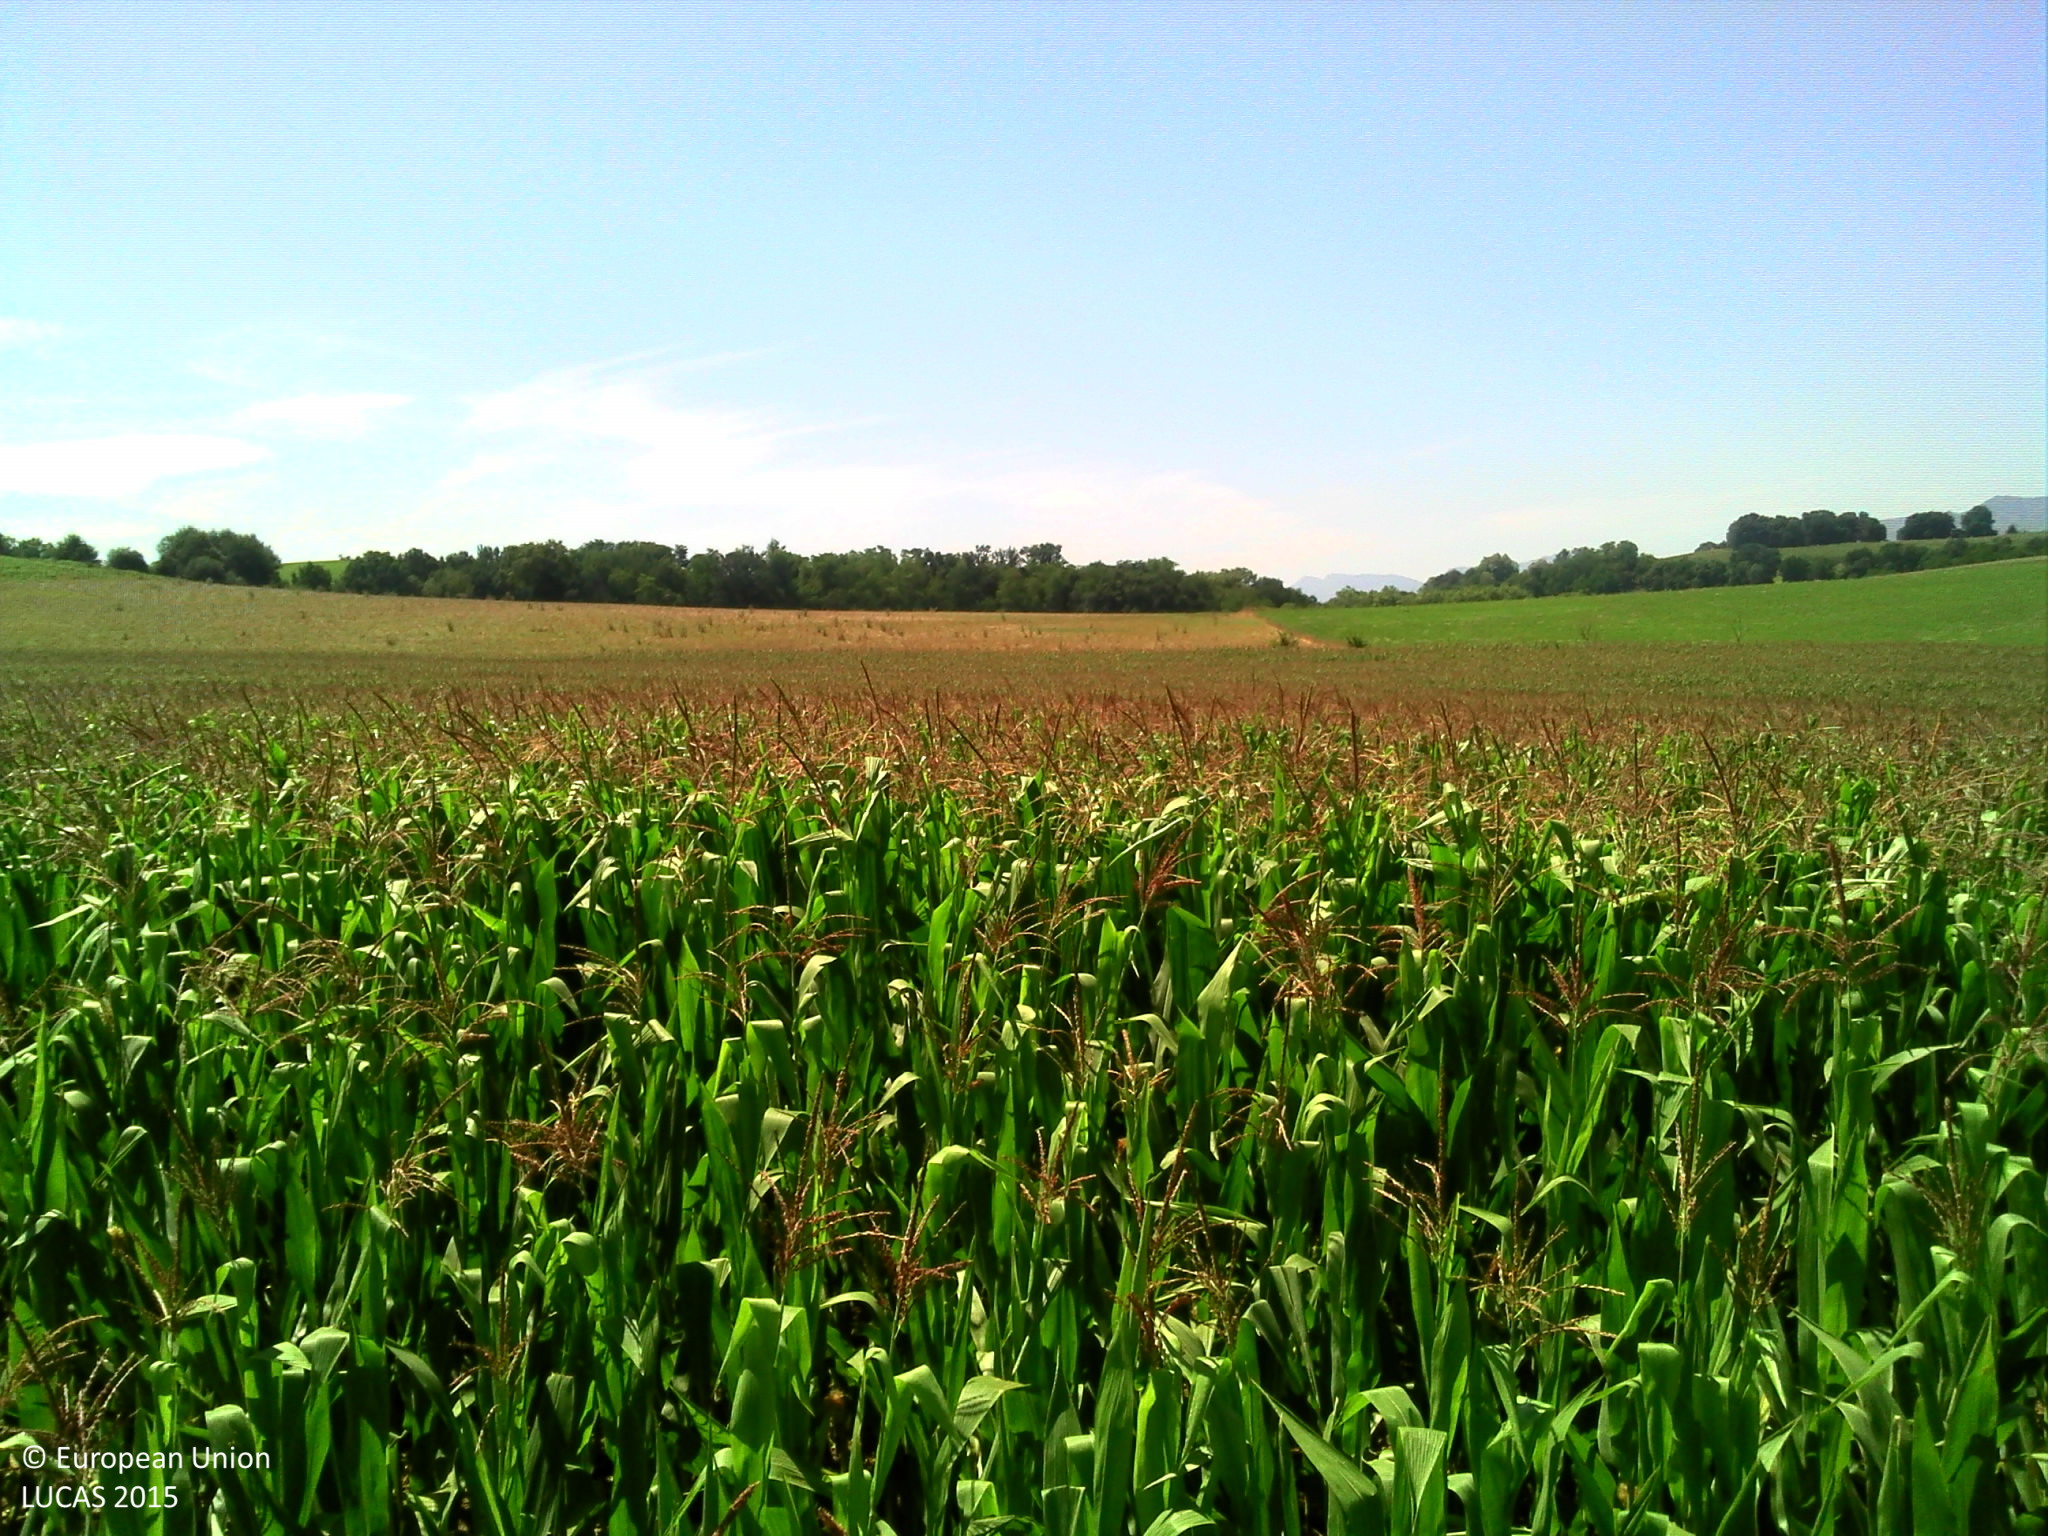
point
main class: Cropland
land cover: Maize
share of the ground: > 75 %
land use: Agriculture (excluding fallow land and kitchen gardens)
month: August
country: FR
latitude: 43.3113
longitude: -1.1469
